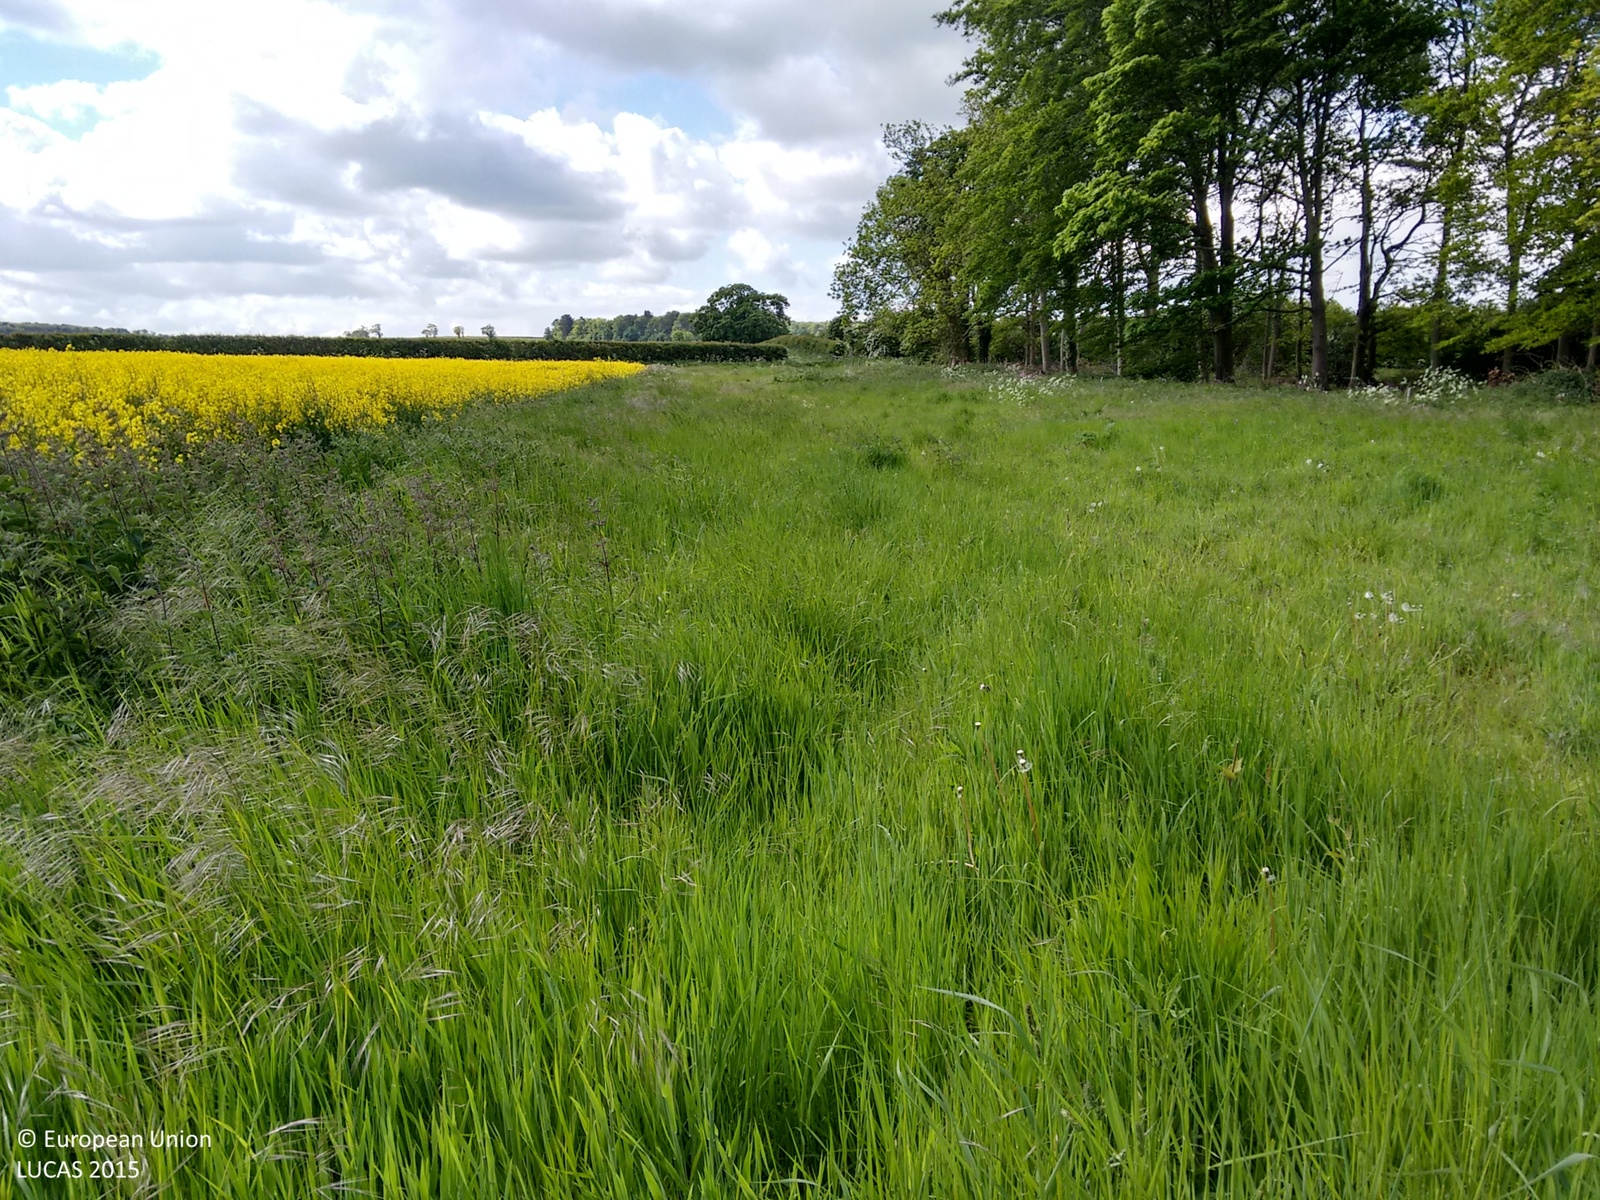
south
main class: Grassland
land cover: Grassland without tree/shrub cover
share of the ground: > 75 %
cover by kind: herbaceous plants 100 %
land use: Agriculture (excluding fallow land and kitchen gardens)
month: May
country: GB
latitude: 53.5458
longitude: -0.2515
